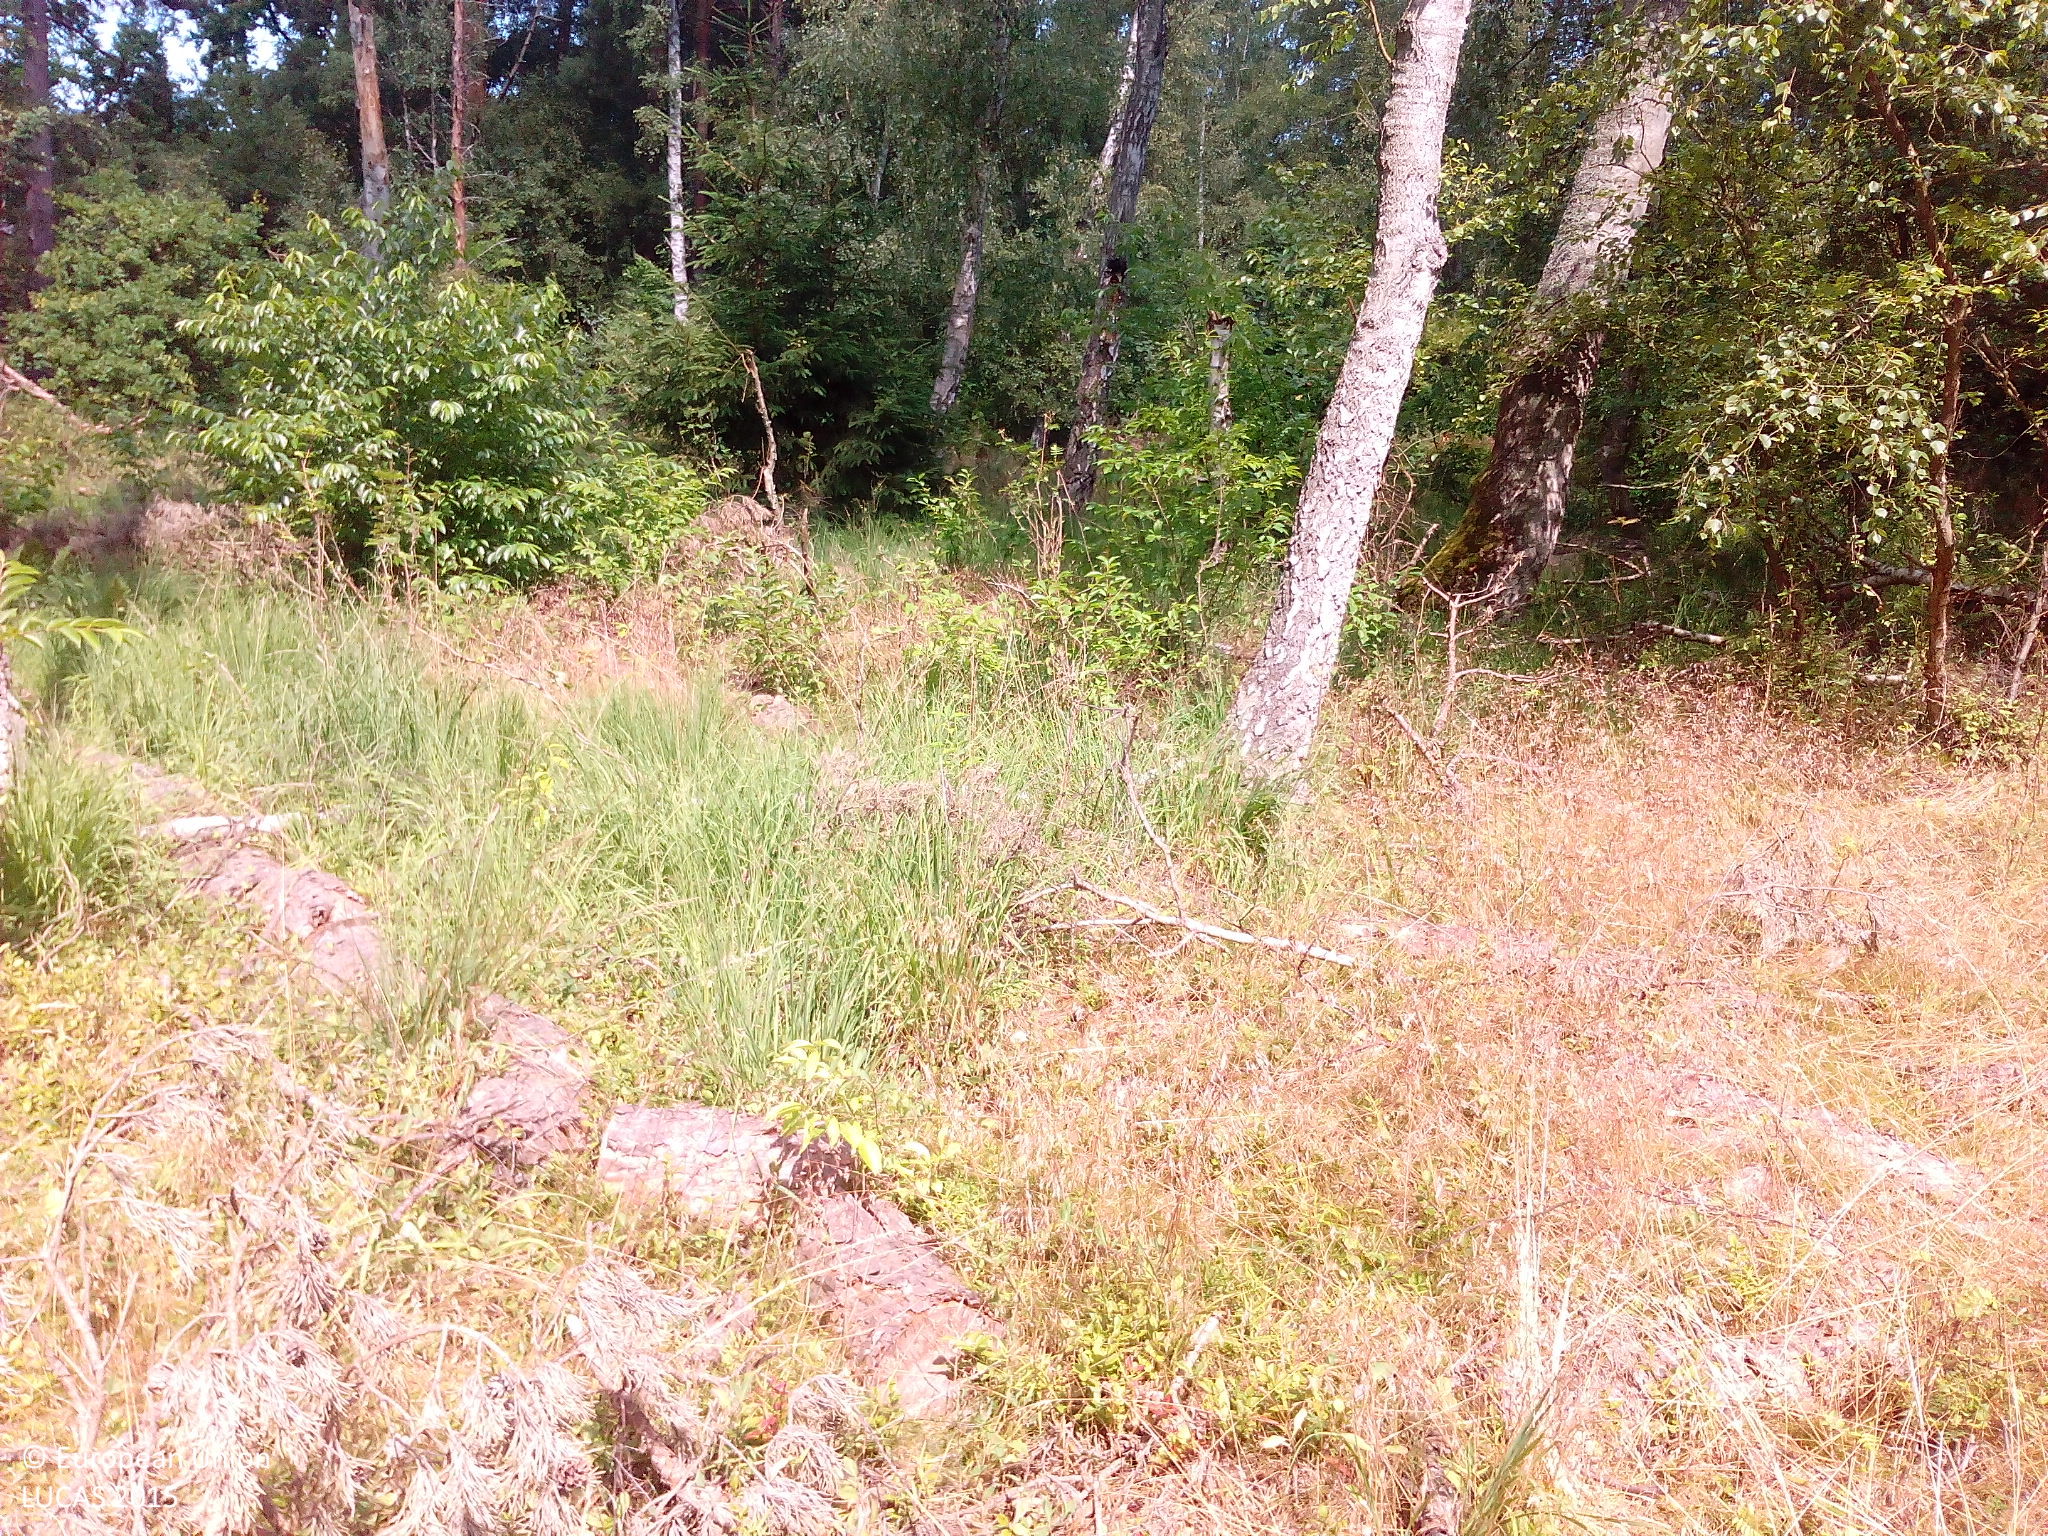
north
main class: Woodland
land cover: Broadleaved woodland
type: mesophytic deciduous forest
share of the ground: 50 - 75 %
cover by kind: broadleaved forest trees 60 %, herbaceous plants 35 %, coniferous forest trees 5 %
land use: Semi-natural and natural areas not in use
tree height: > 5 m
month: July
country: DE
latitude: 54.4336
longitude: 12.6659
